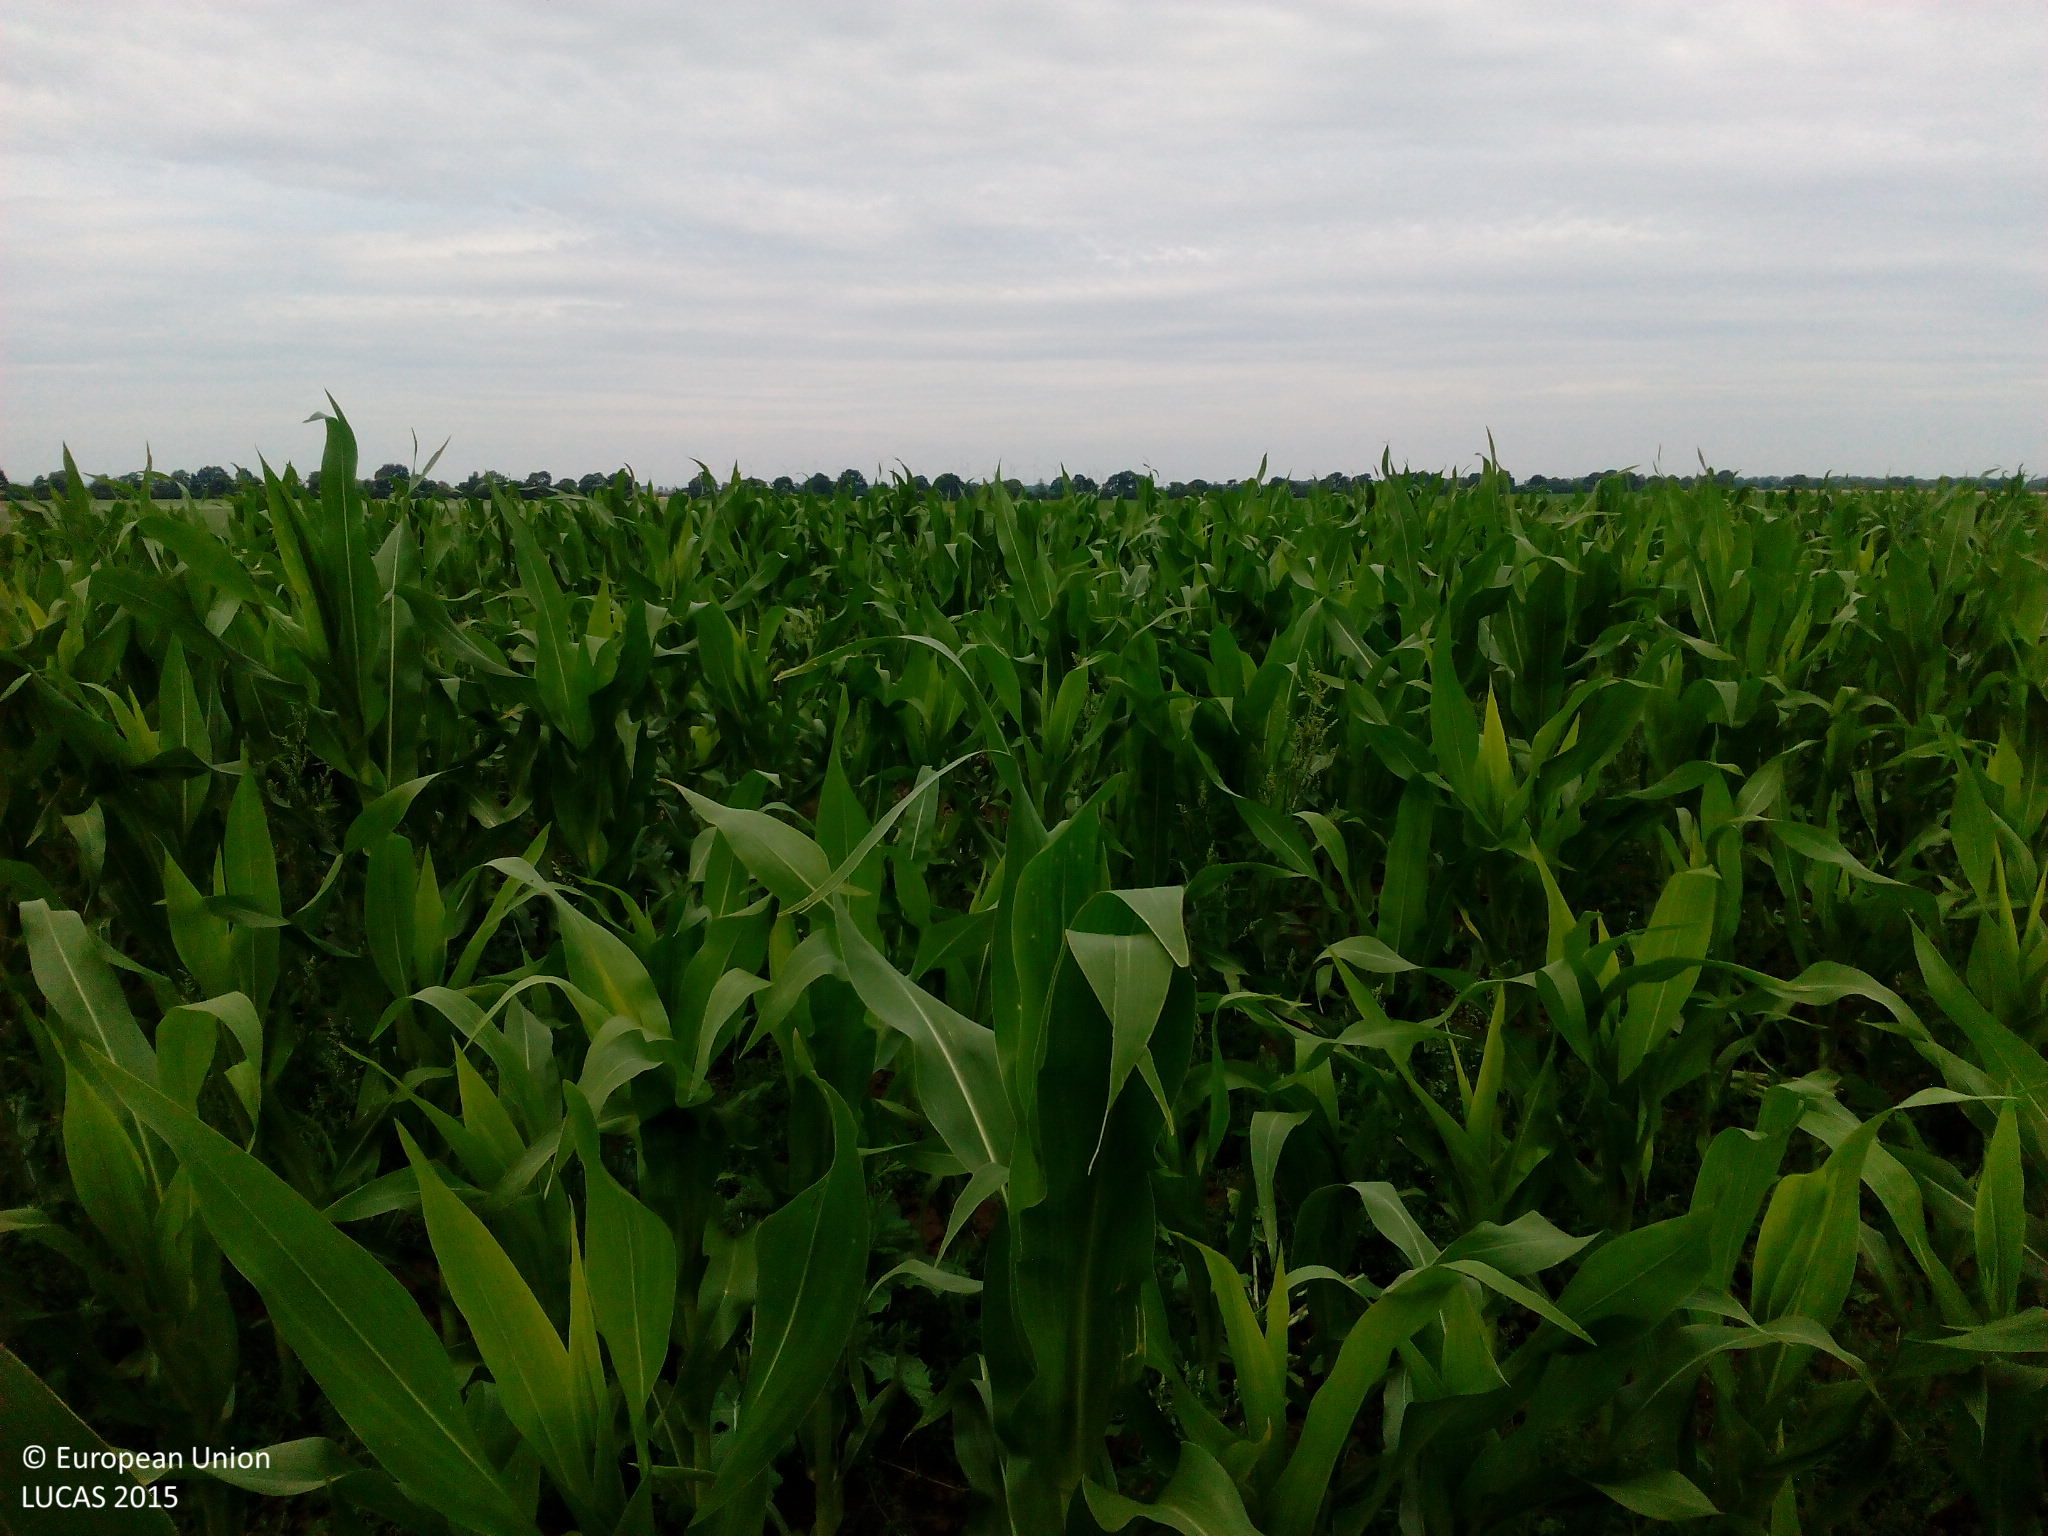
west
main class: Cropland
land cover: Maize
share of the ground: > 75 %
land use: Agriculture (excluding fallow land and kitchen gardens)
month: July
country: DE
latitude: 51.9718
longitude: 11.5572
